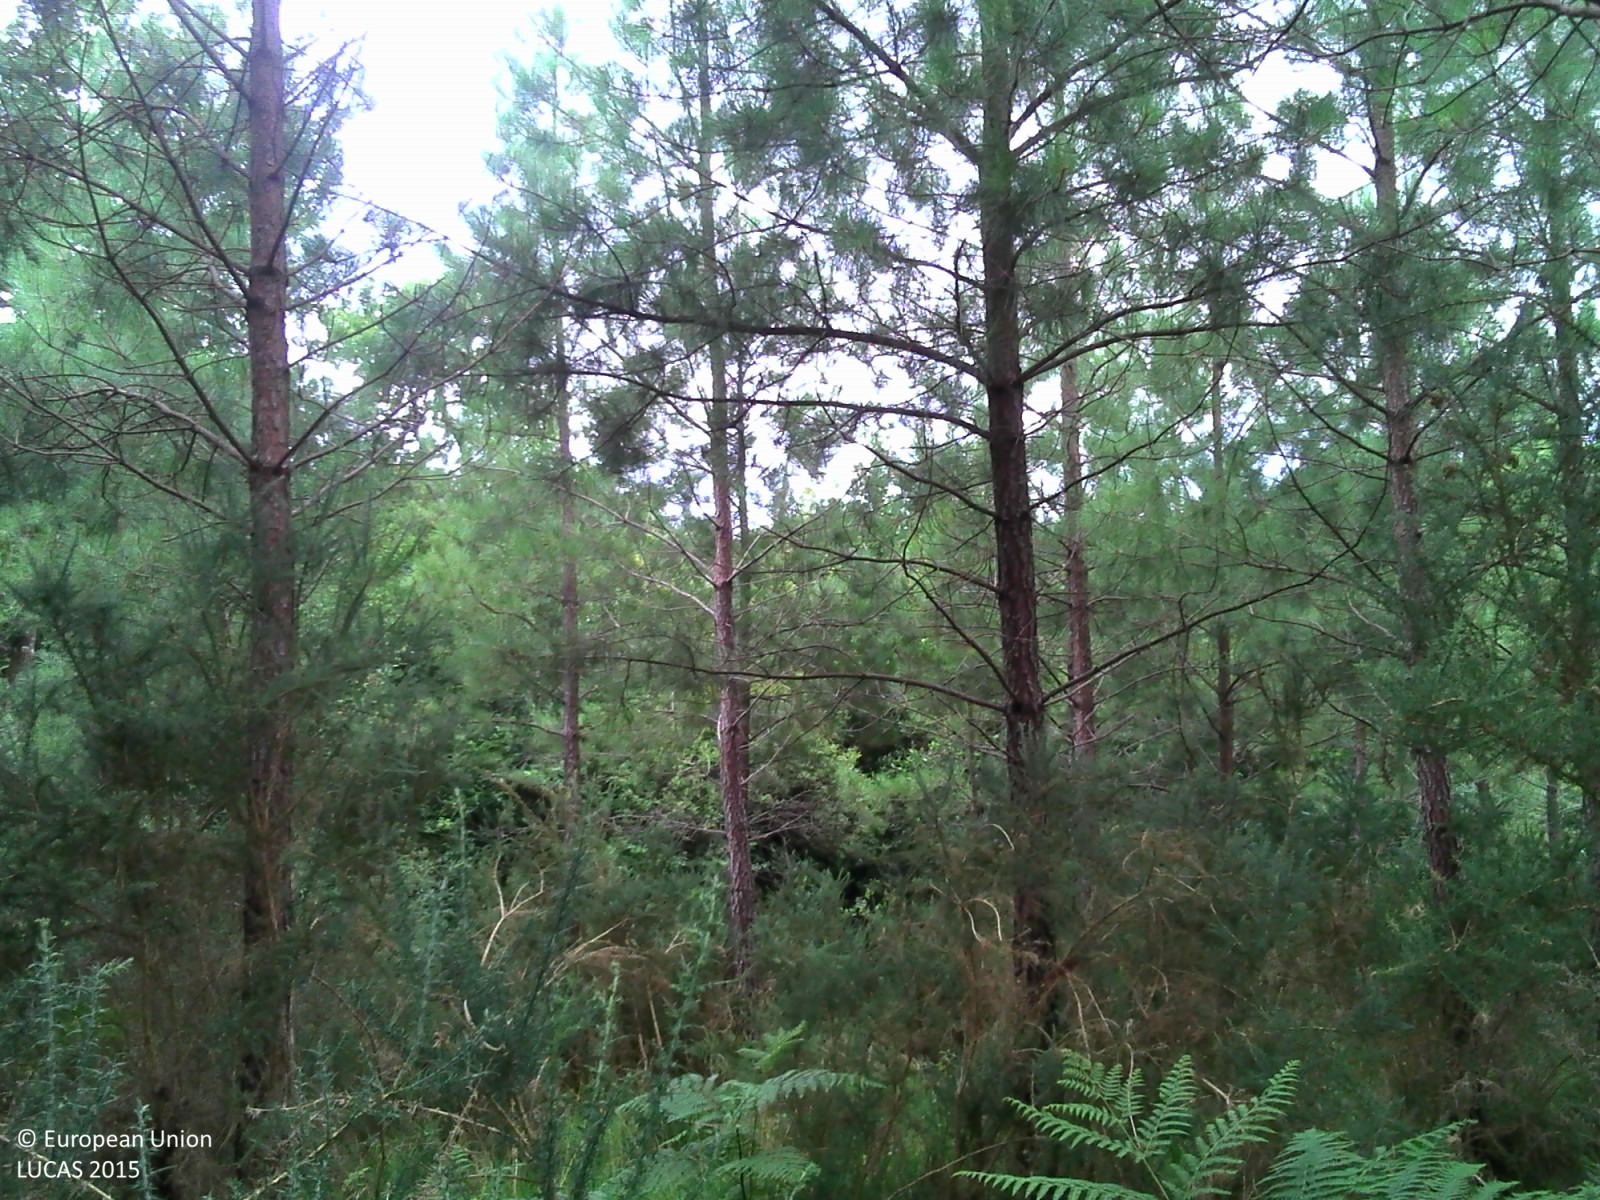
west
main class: Woodland
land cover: Pine dominated coniferous woodland
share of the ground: > 75 %
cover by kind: coniferous forest trees 85 %, herbaceous plants 10 %, broadleaved forest trees 5 %
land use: Forestry
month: July
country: FR
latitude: 43.5911
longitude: -1.2510
